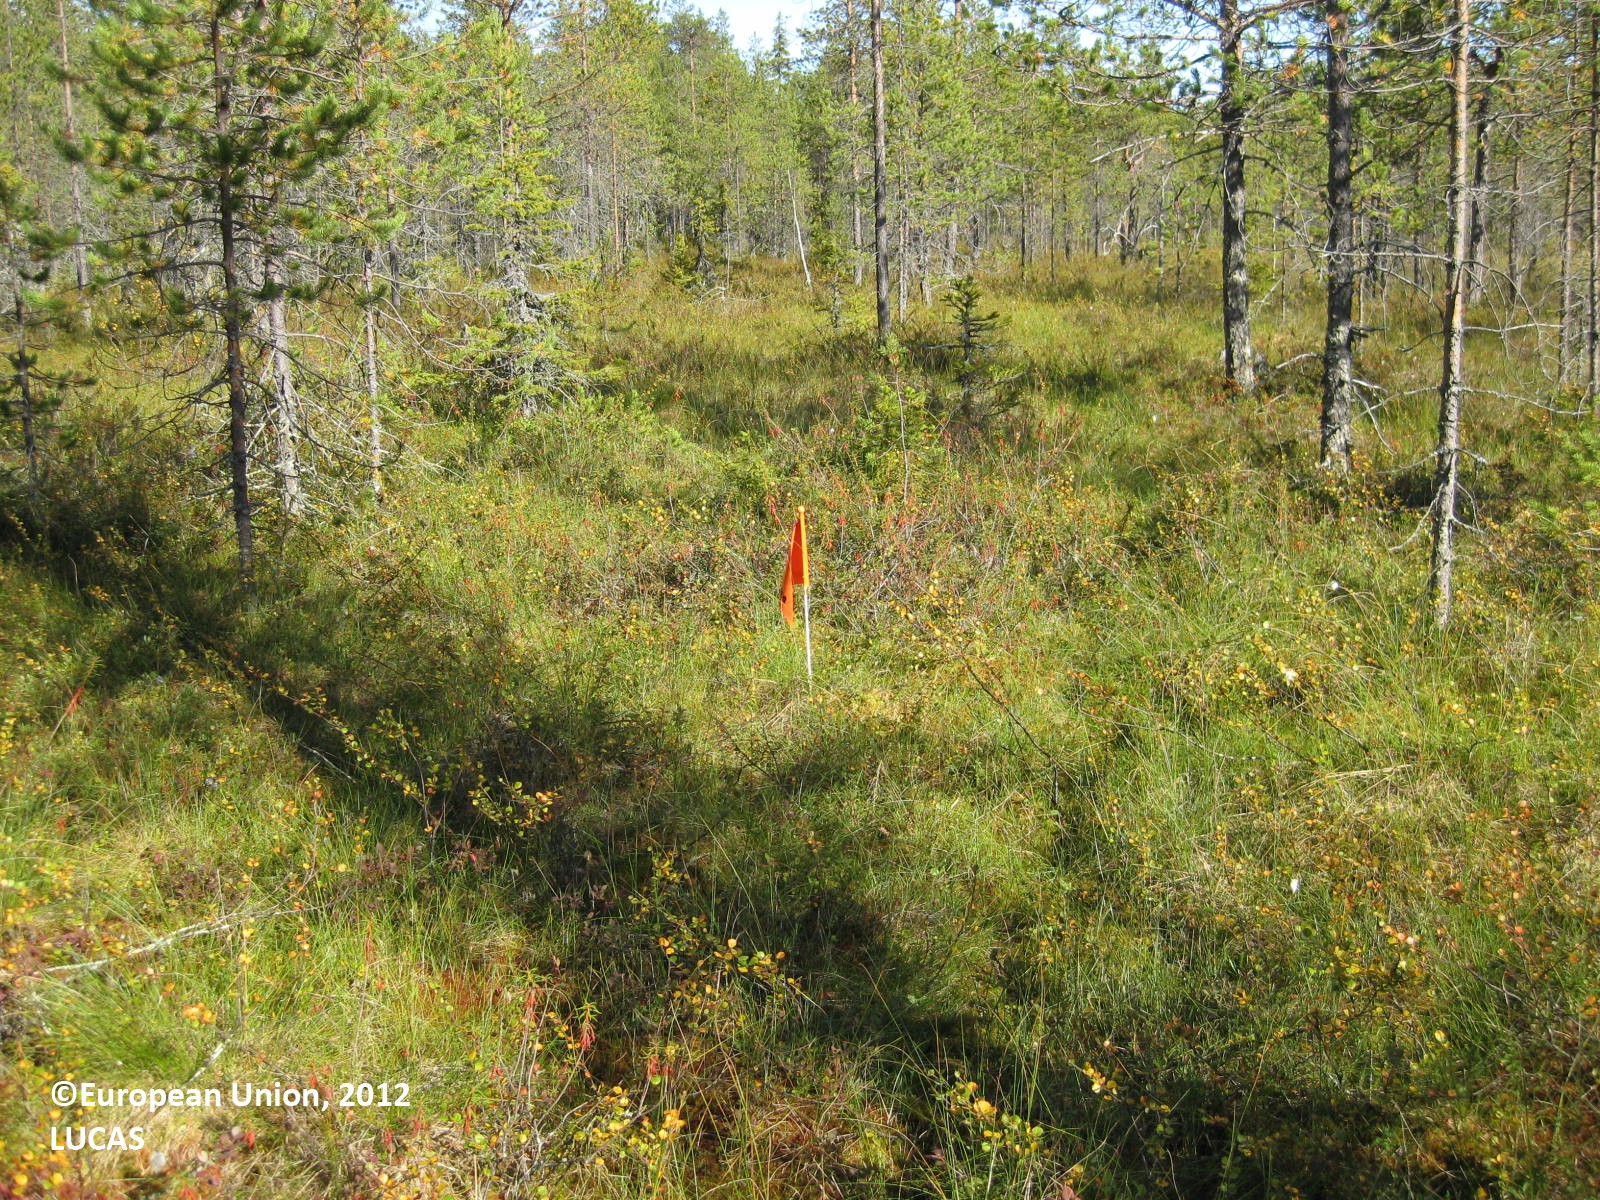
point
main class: Woodland
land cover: Pine dominated coniferous woodland
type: boreal forest
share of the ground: 50 - 75 %
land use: Forestry
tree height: > 5 m
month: August
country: FI
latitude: 66.0642
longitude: 29.6097
